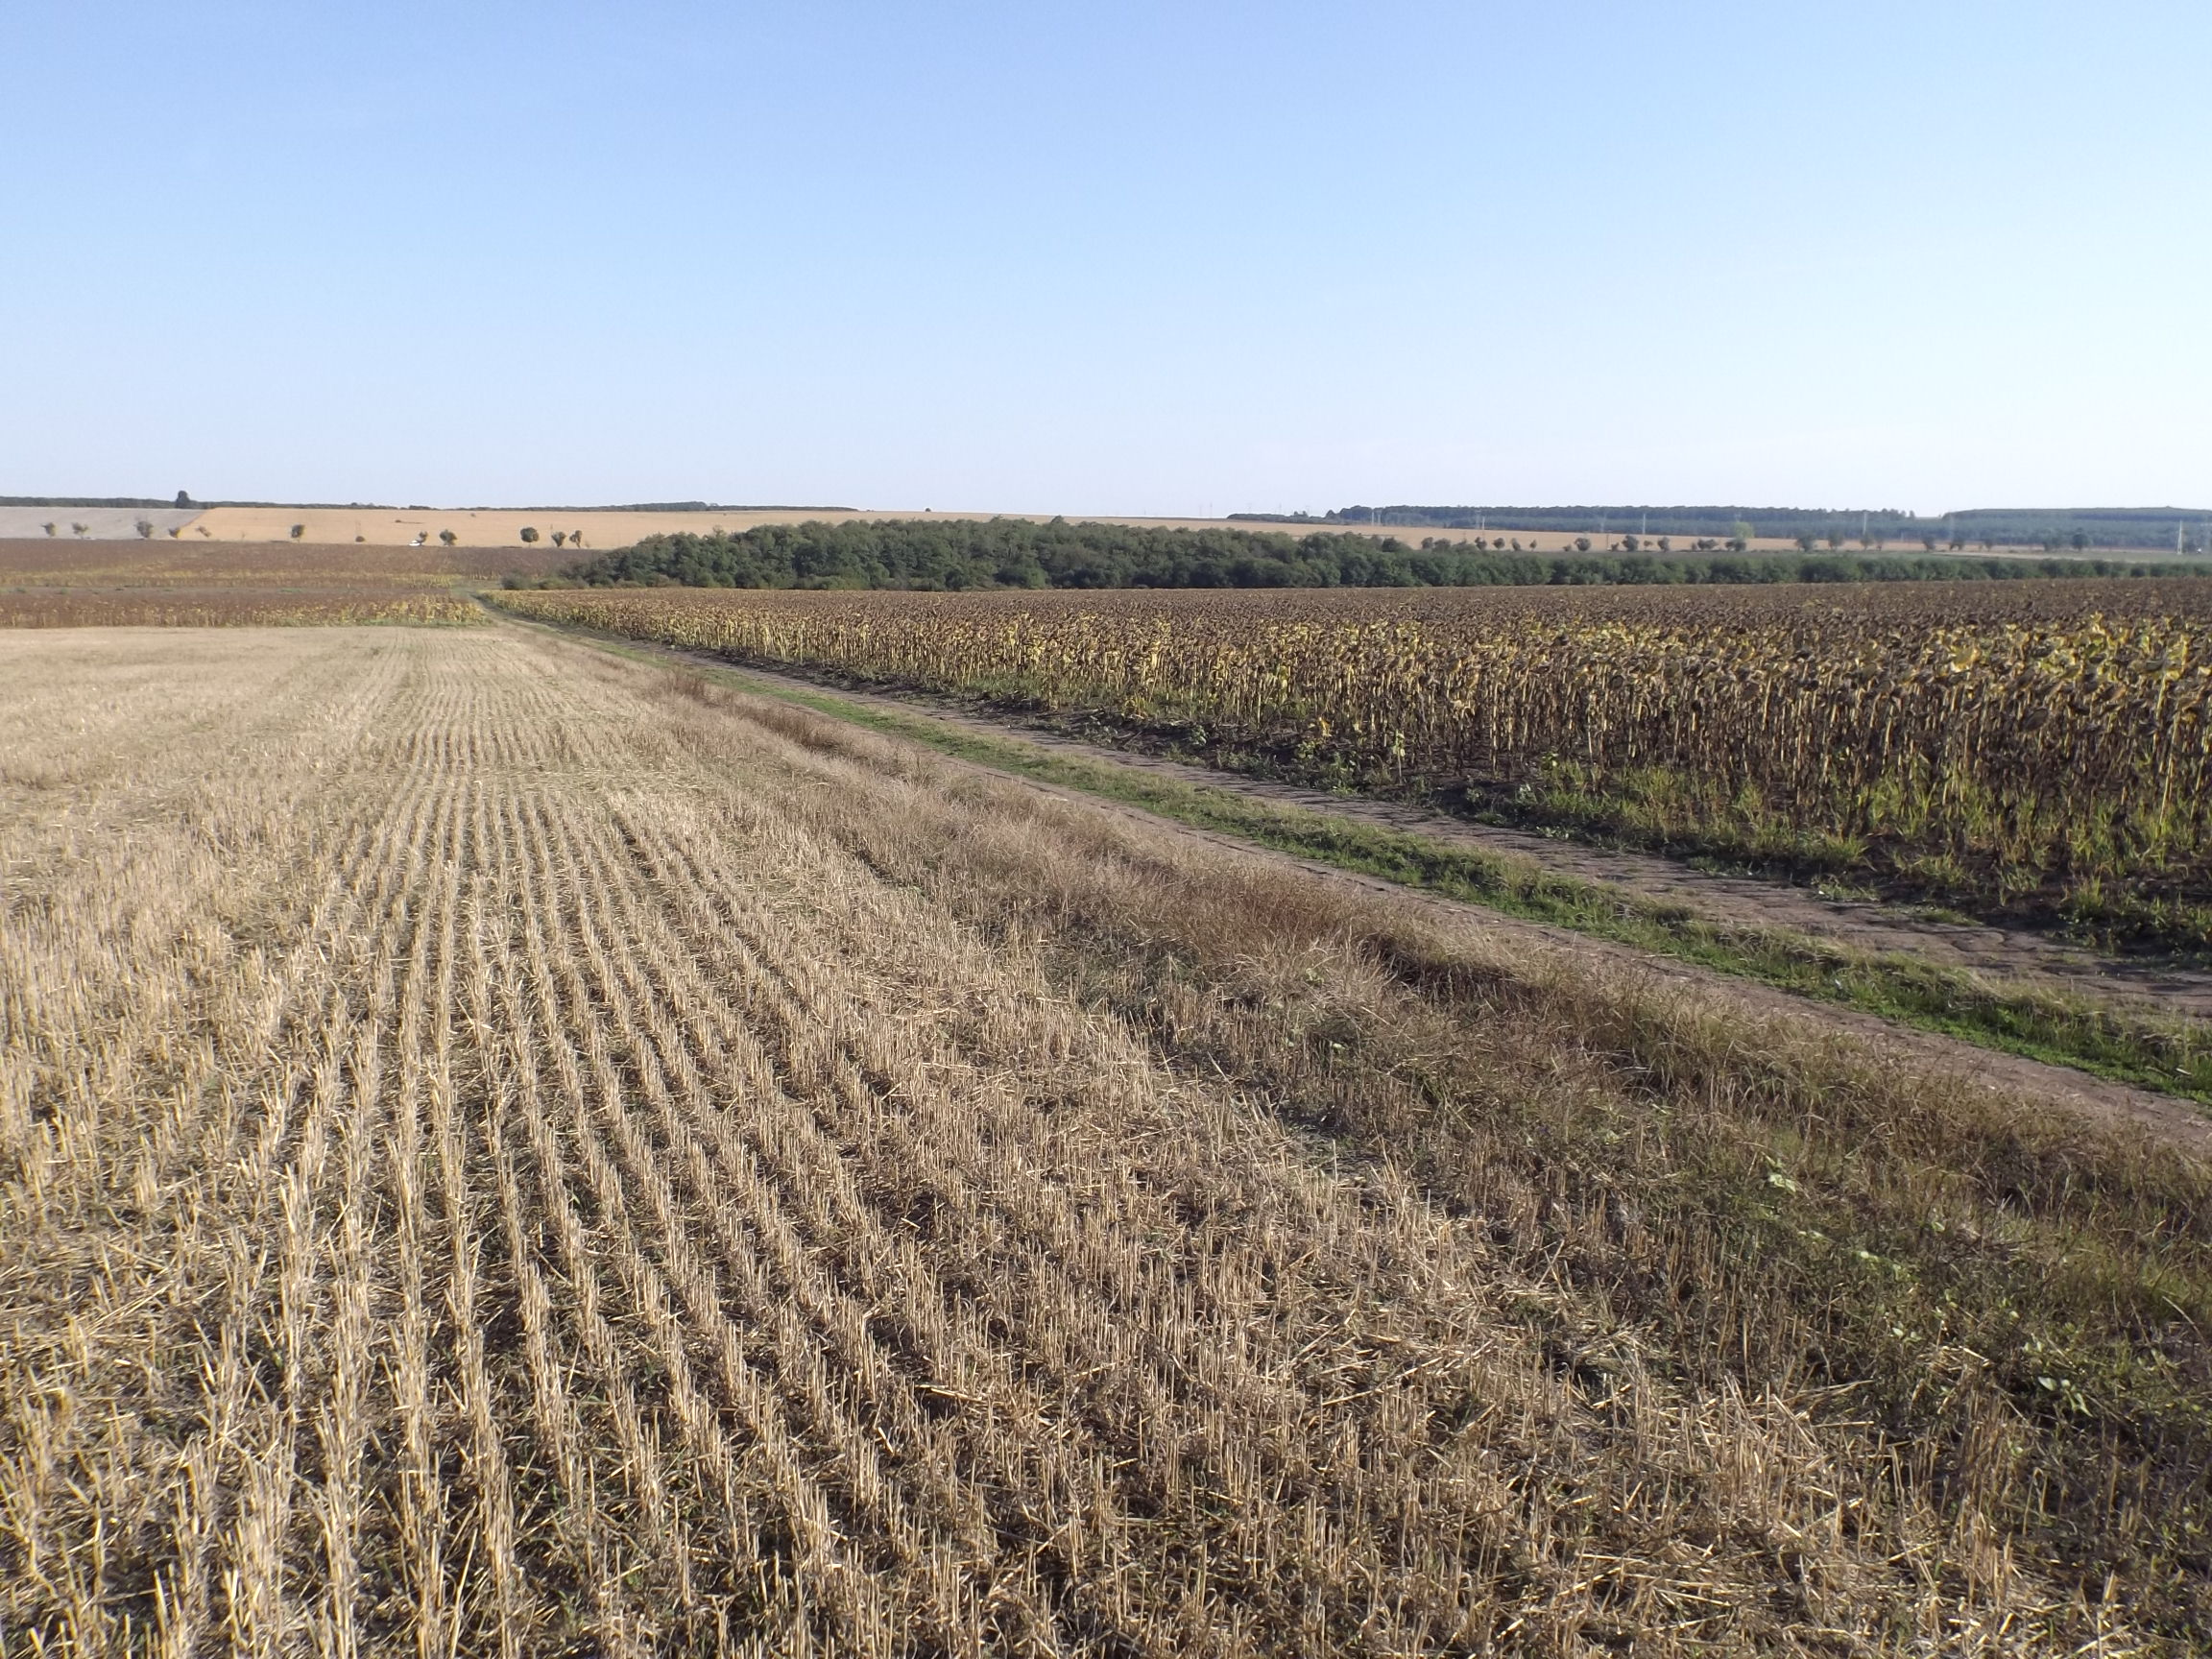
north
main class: Cropland
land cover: Common wheat
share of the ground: 25 - 50 %
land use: Agriculture (excluding fallow land and kitchen gardens)
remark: Harvested field
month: August
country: BG
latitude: 43.3973
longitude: 27.5268
